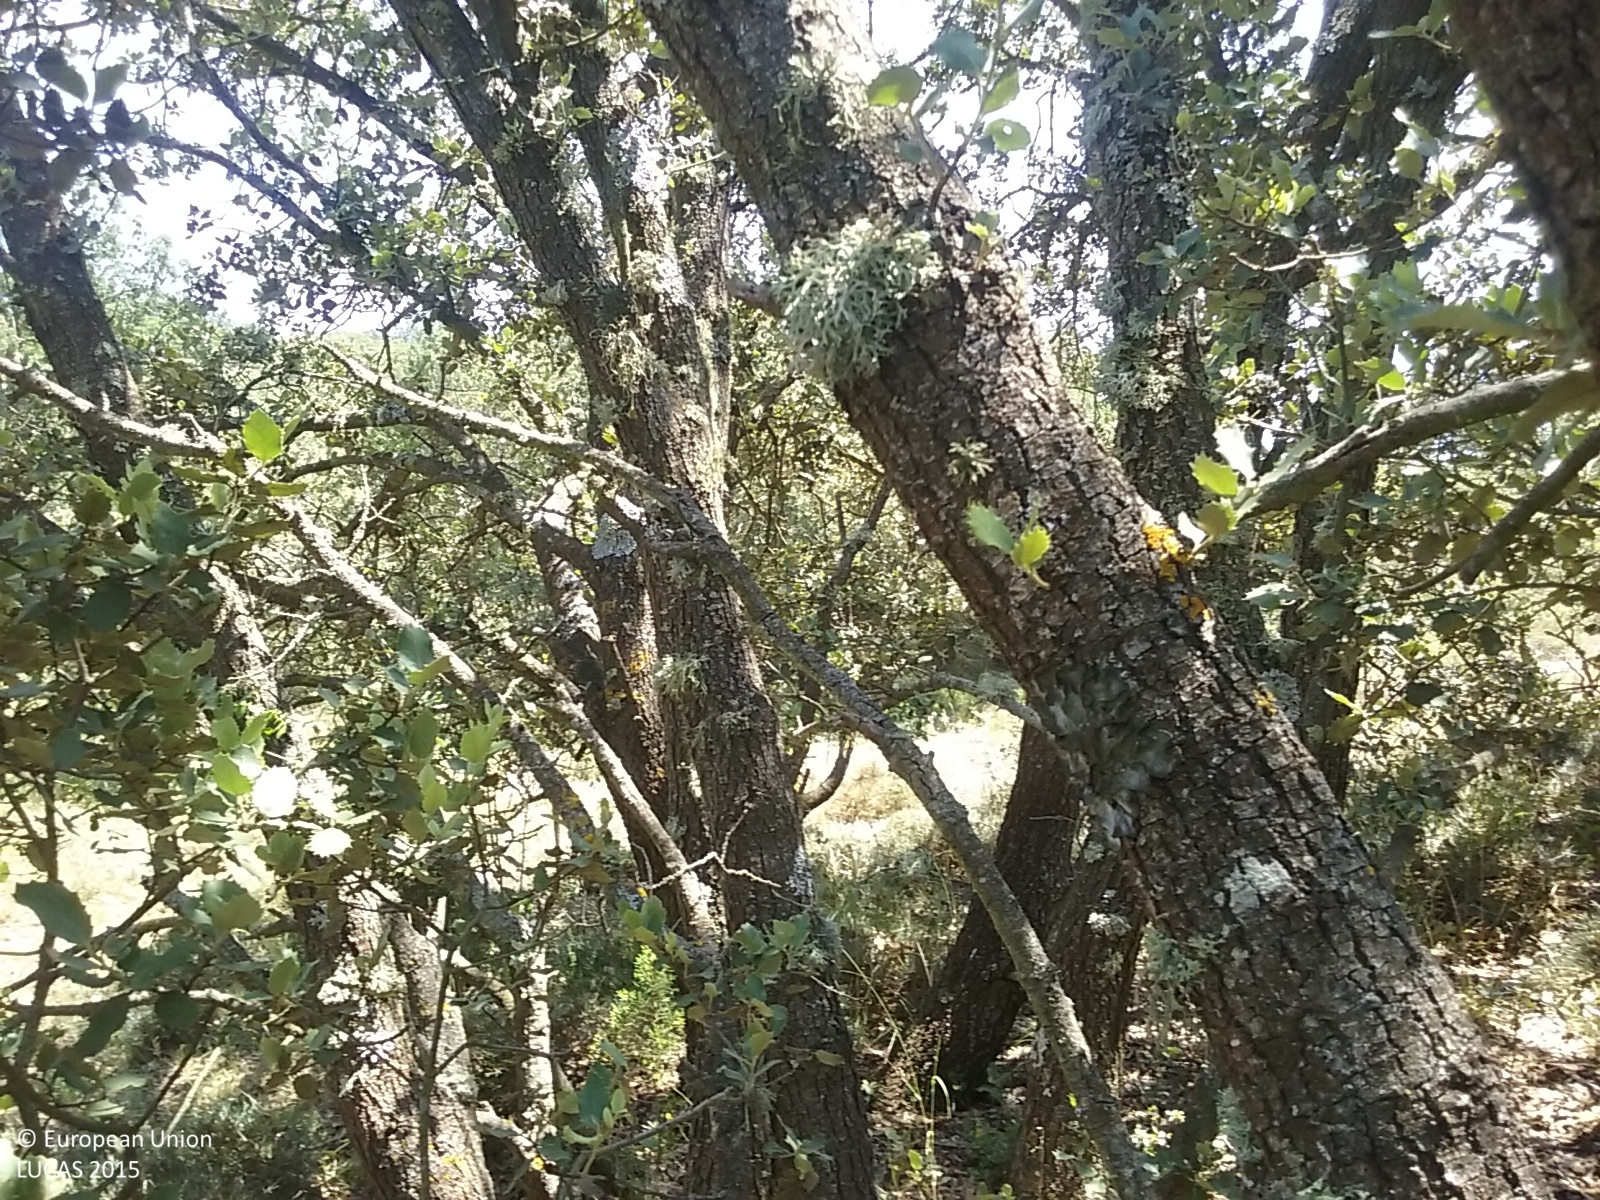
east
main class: Woodland
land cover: Broadleaved woodland
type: broadleaved evergreen forest
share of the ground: > 75 %
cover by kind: broadleaved forest trees 95 %, herbaceous plants 5 %
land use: Semi-natural and natural areas not in use
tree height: < 5 m
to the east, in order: Broadleaved woodland; Tracks; Broadleaved woodland; Dry stone walls; Broadleaved woodland; Dry stone walls; Broadleaved woodland; Dry stone walls; Broadleaved woodland; Dry stone walls; Broadleaved woodland
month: July
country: ES
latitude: 39.9524
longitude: -0.7143
